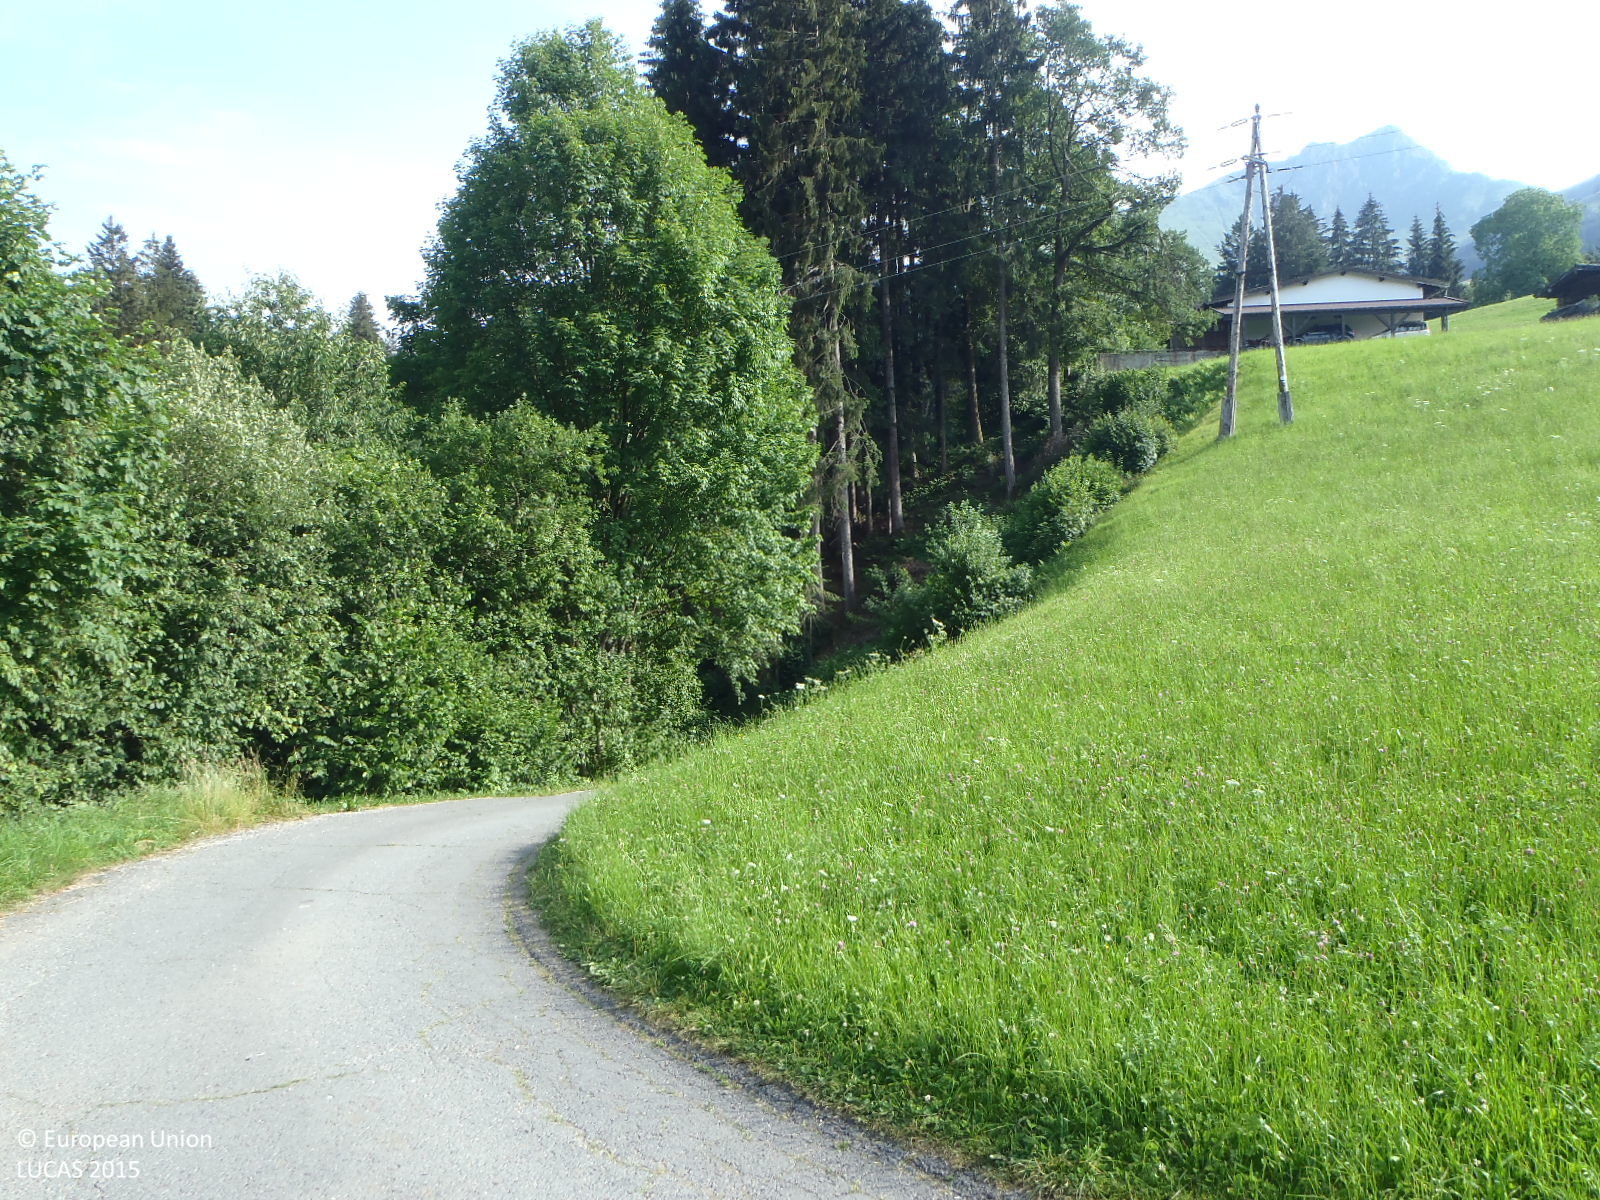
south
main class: Grassland
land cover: Grassland without tree/shrub cover
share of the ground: > 75 %
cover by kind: herbaceous plants 100 %
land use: Agriculture (excluding fallow land and kitchen gardens)
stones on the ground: < 10 %
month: July
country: AT
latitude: 47.5120
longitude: 12.4548
